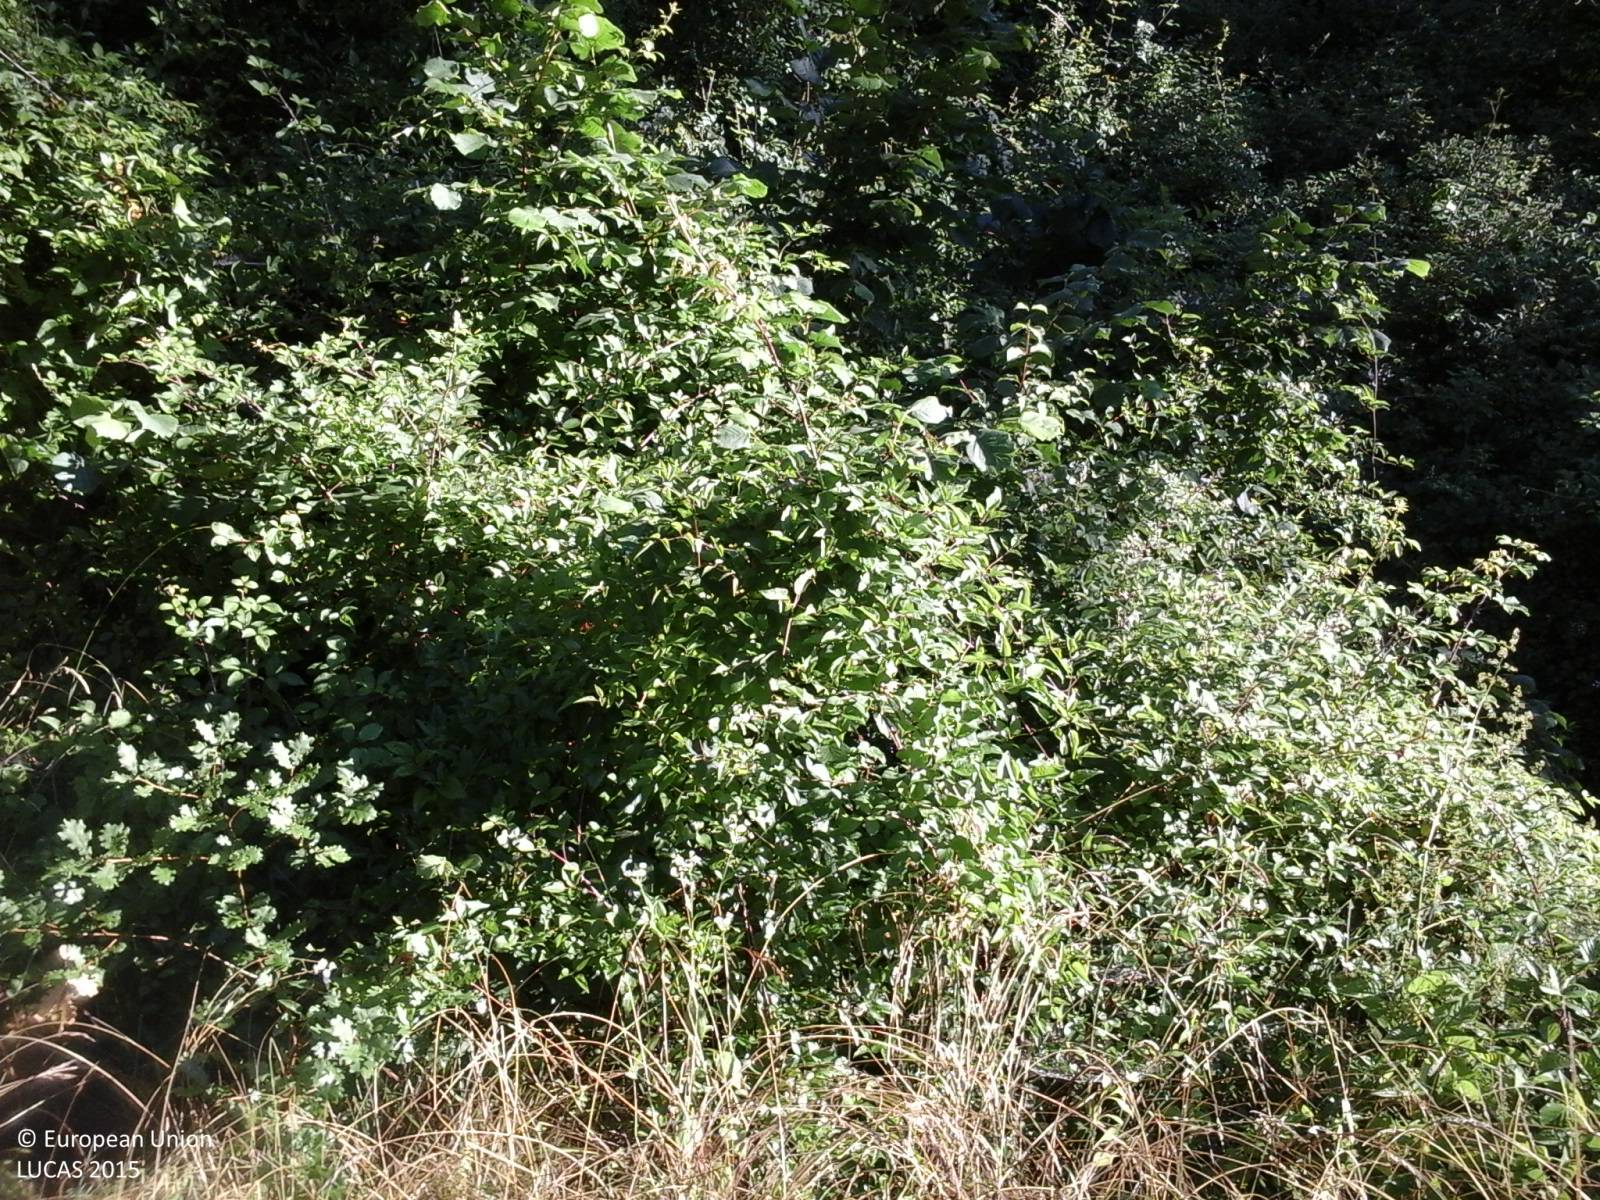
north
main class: Woodland
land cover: Broadleaved woodland
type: thermophilous deciduous forest
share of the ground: > 75 %
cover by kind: broadleaved forest trees 100 %
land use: Forestry
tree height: > 5 m
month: June
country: IT
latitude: 44.2603
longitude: 9.9125
